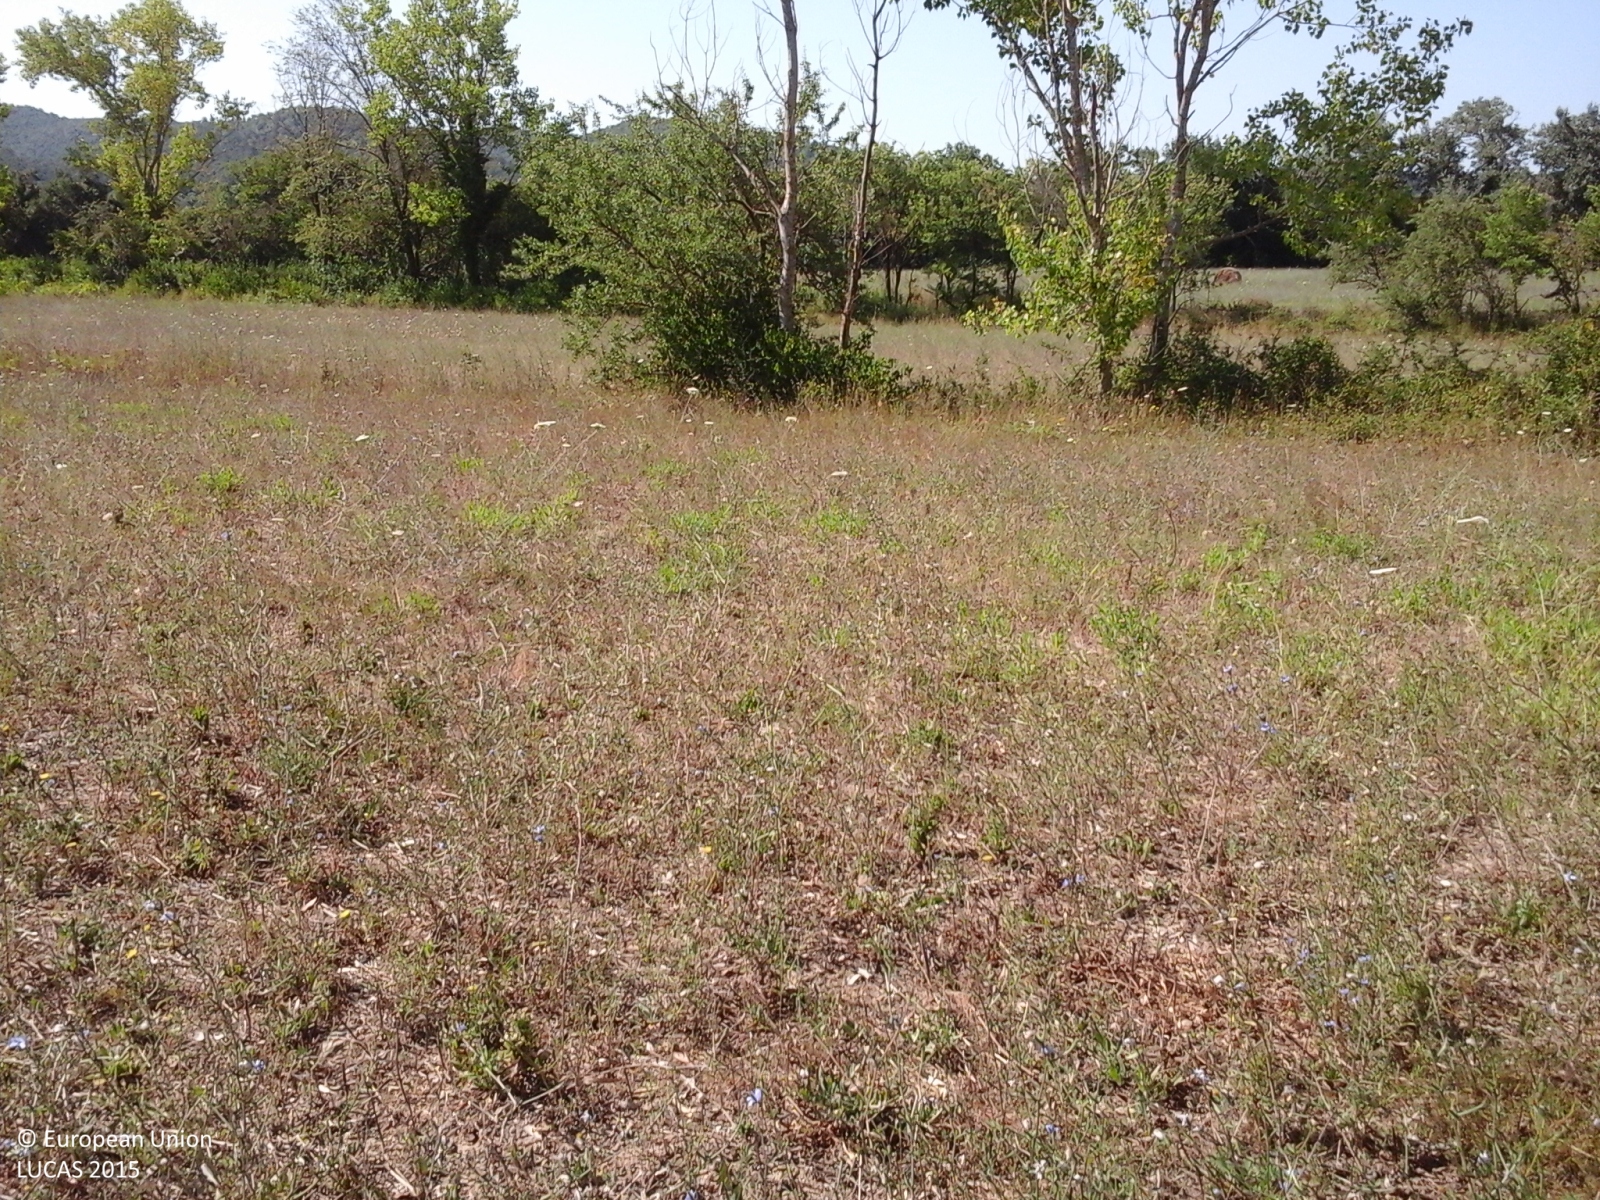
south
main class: Grassland
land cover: Spontaneously vegetated surfaces
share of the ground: > 75 %
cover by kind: herbaceous plants 100 %
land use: Agriculture (excluding fallow land and kitchen gardens)
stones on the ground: < 10 %
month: July
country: IT
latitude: 42.9747
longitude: 10.9412
